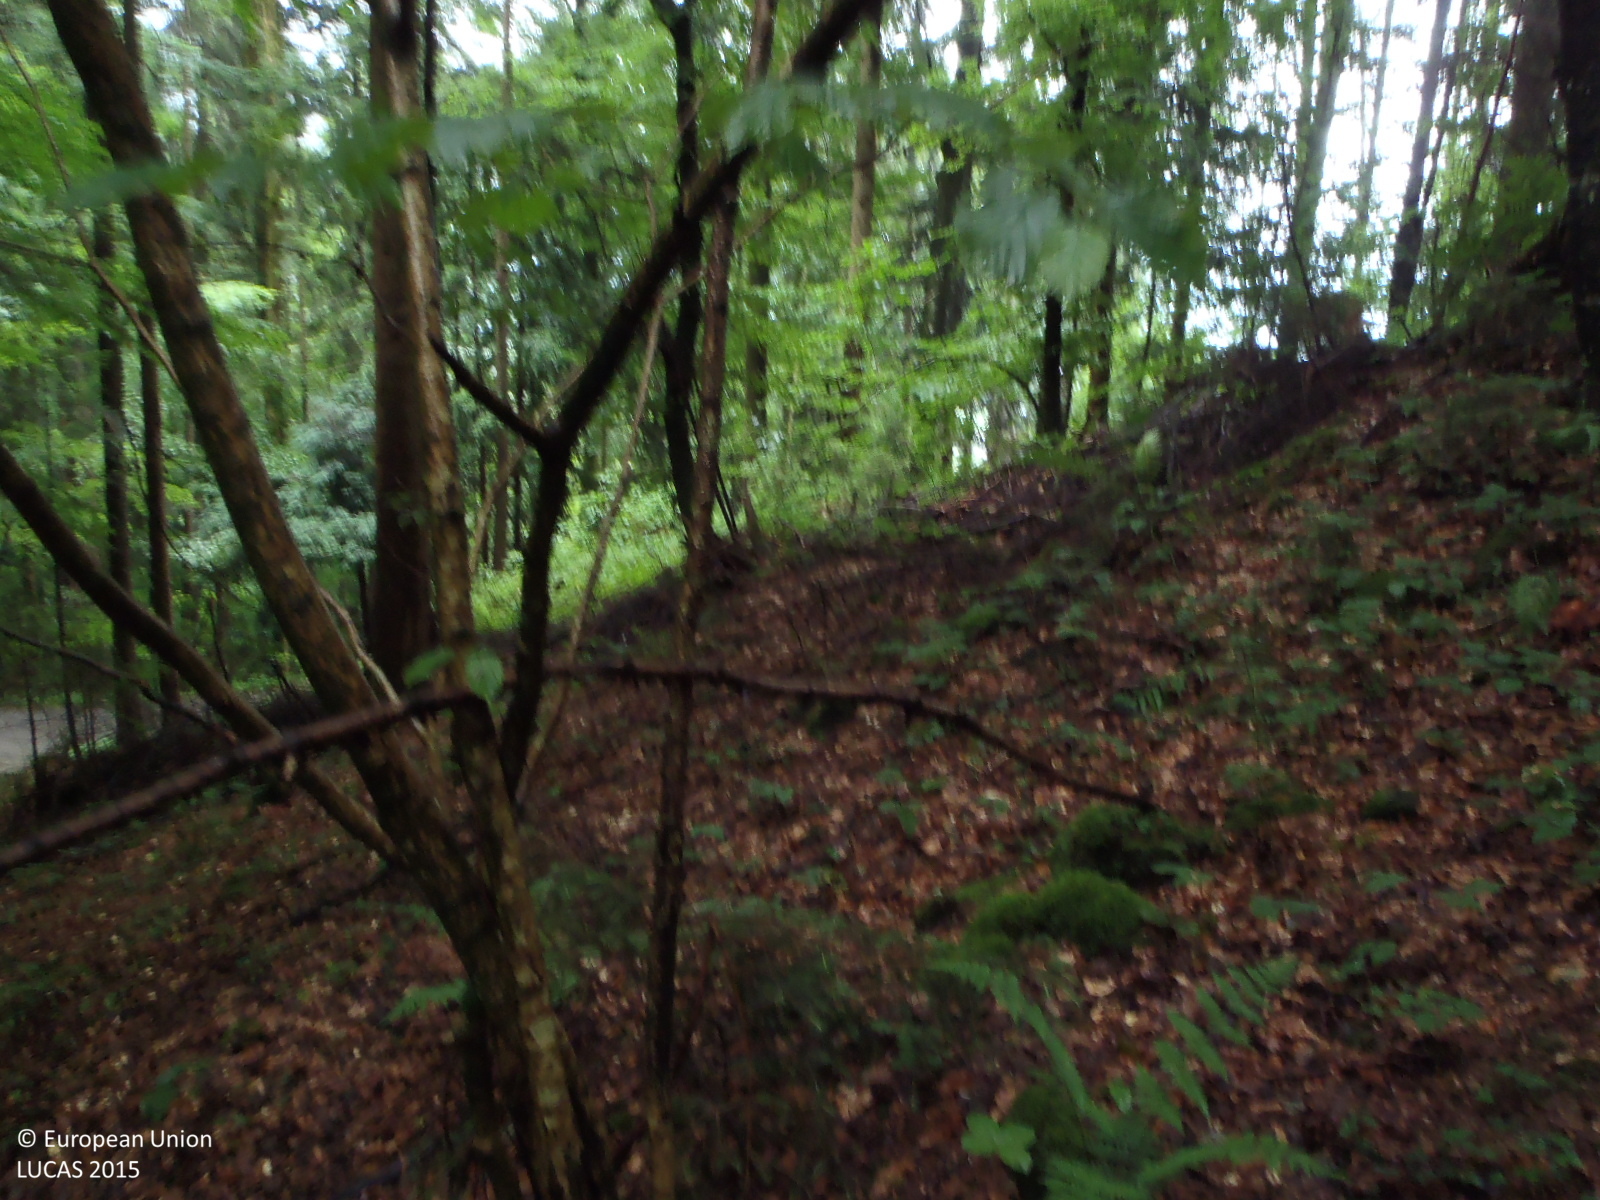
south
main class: Woodland
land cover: Broadleaved woodland
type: mountainous beech forest
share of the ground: > 75 %
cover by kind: broadleaved forest trees 80 %, coniferous forest trees 20 %
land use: Forestry
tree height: > 5 m
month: July
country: AT
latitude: 47.6610
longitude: 12.2223
